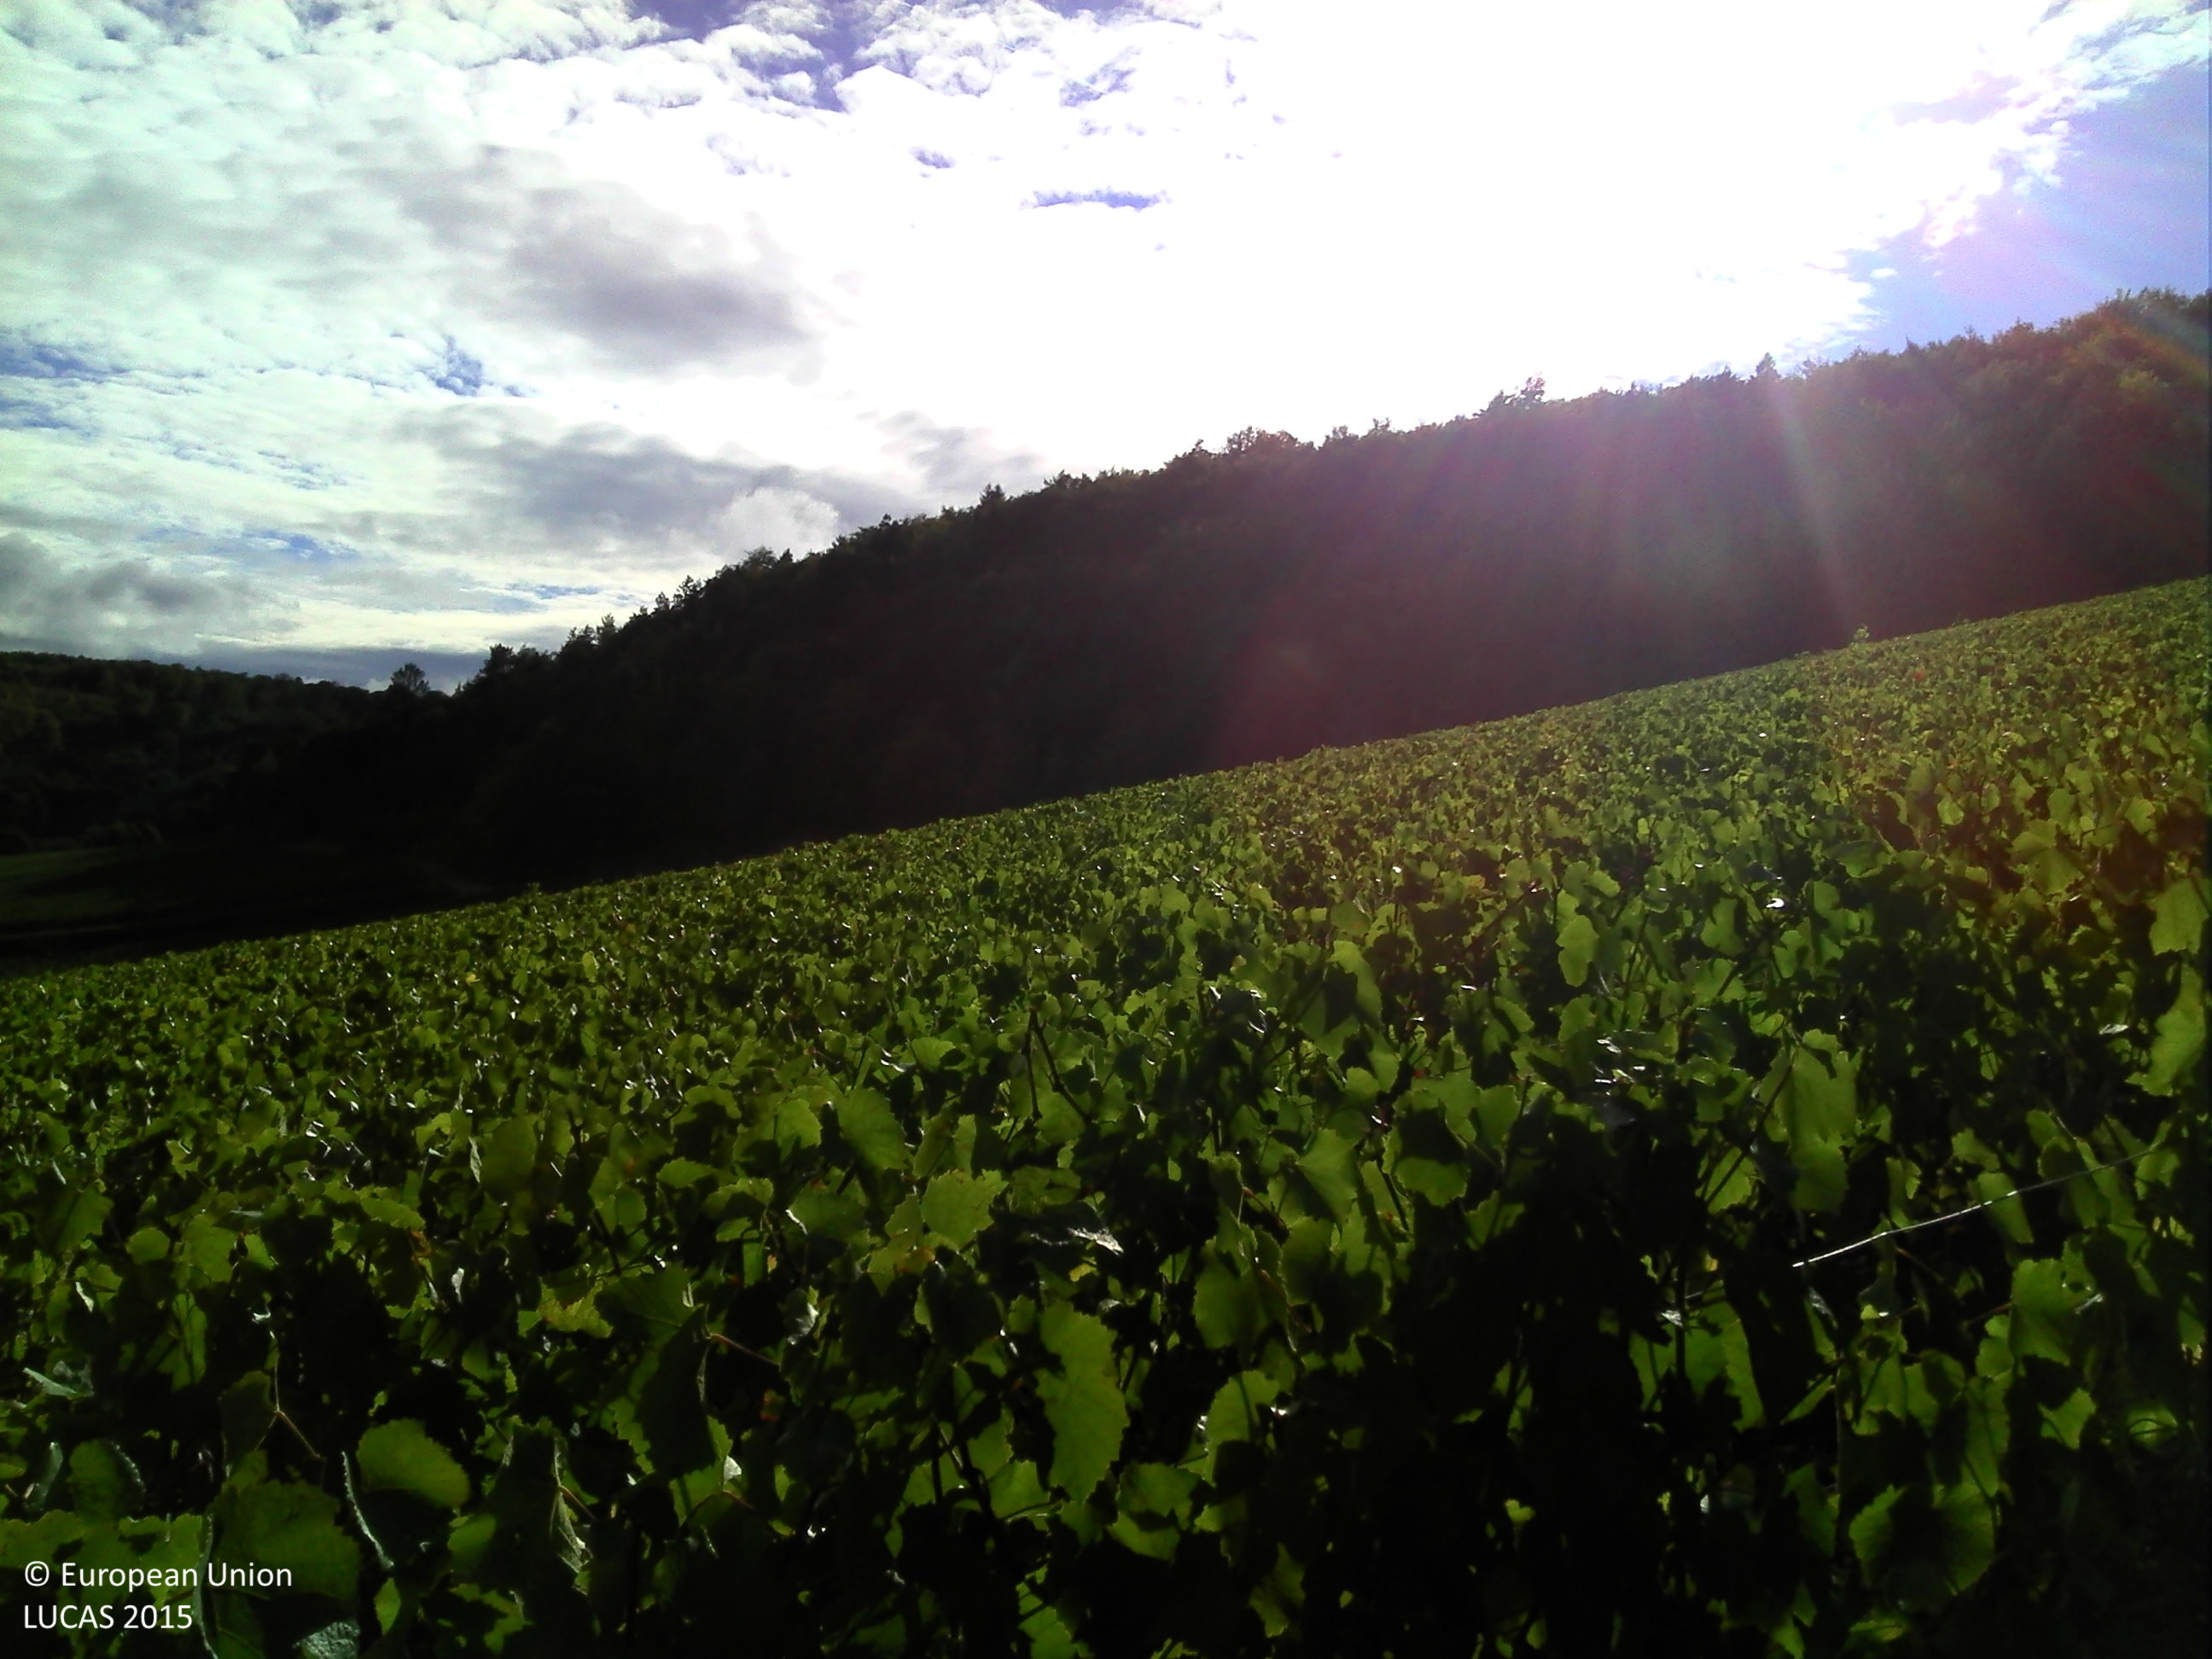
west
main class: Cropland
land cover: Vineyards
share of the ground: 25 - 50 %
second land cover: Other bare soil
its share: > 75 %
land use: Agriculture (excluding fallow land and kitchen gardens)
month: September
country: FR
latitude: 48.1868
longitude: 4.7119
